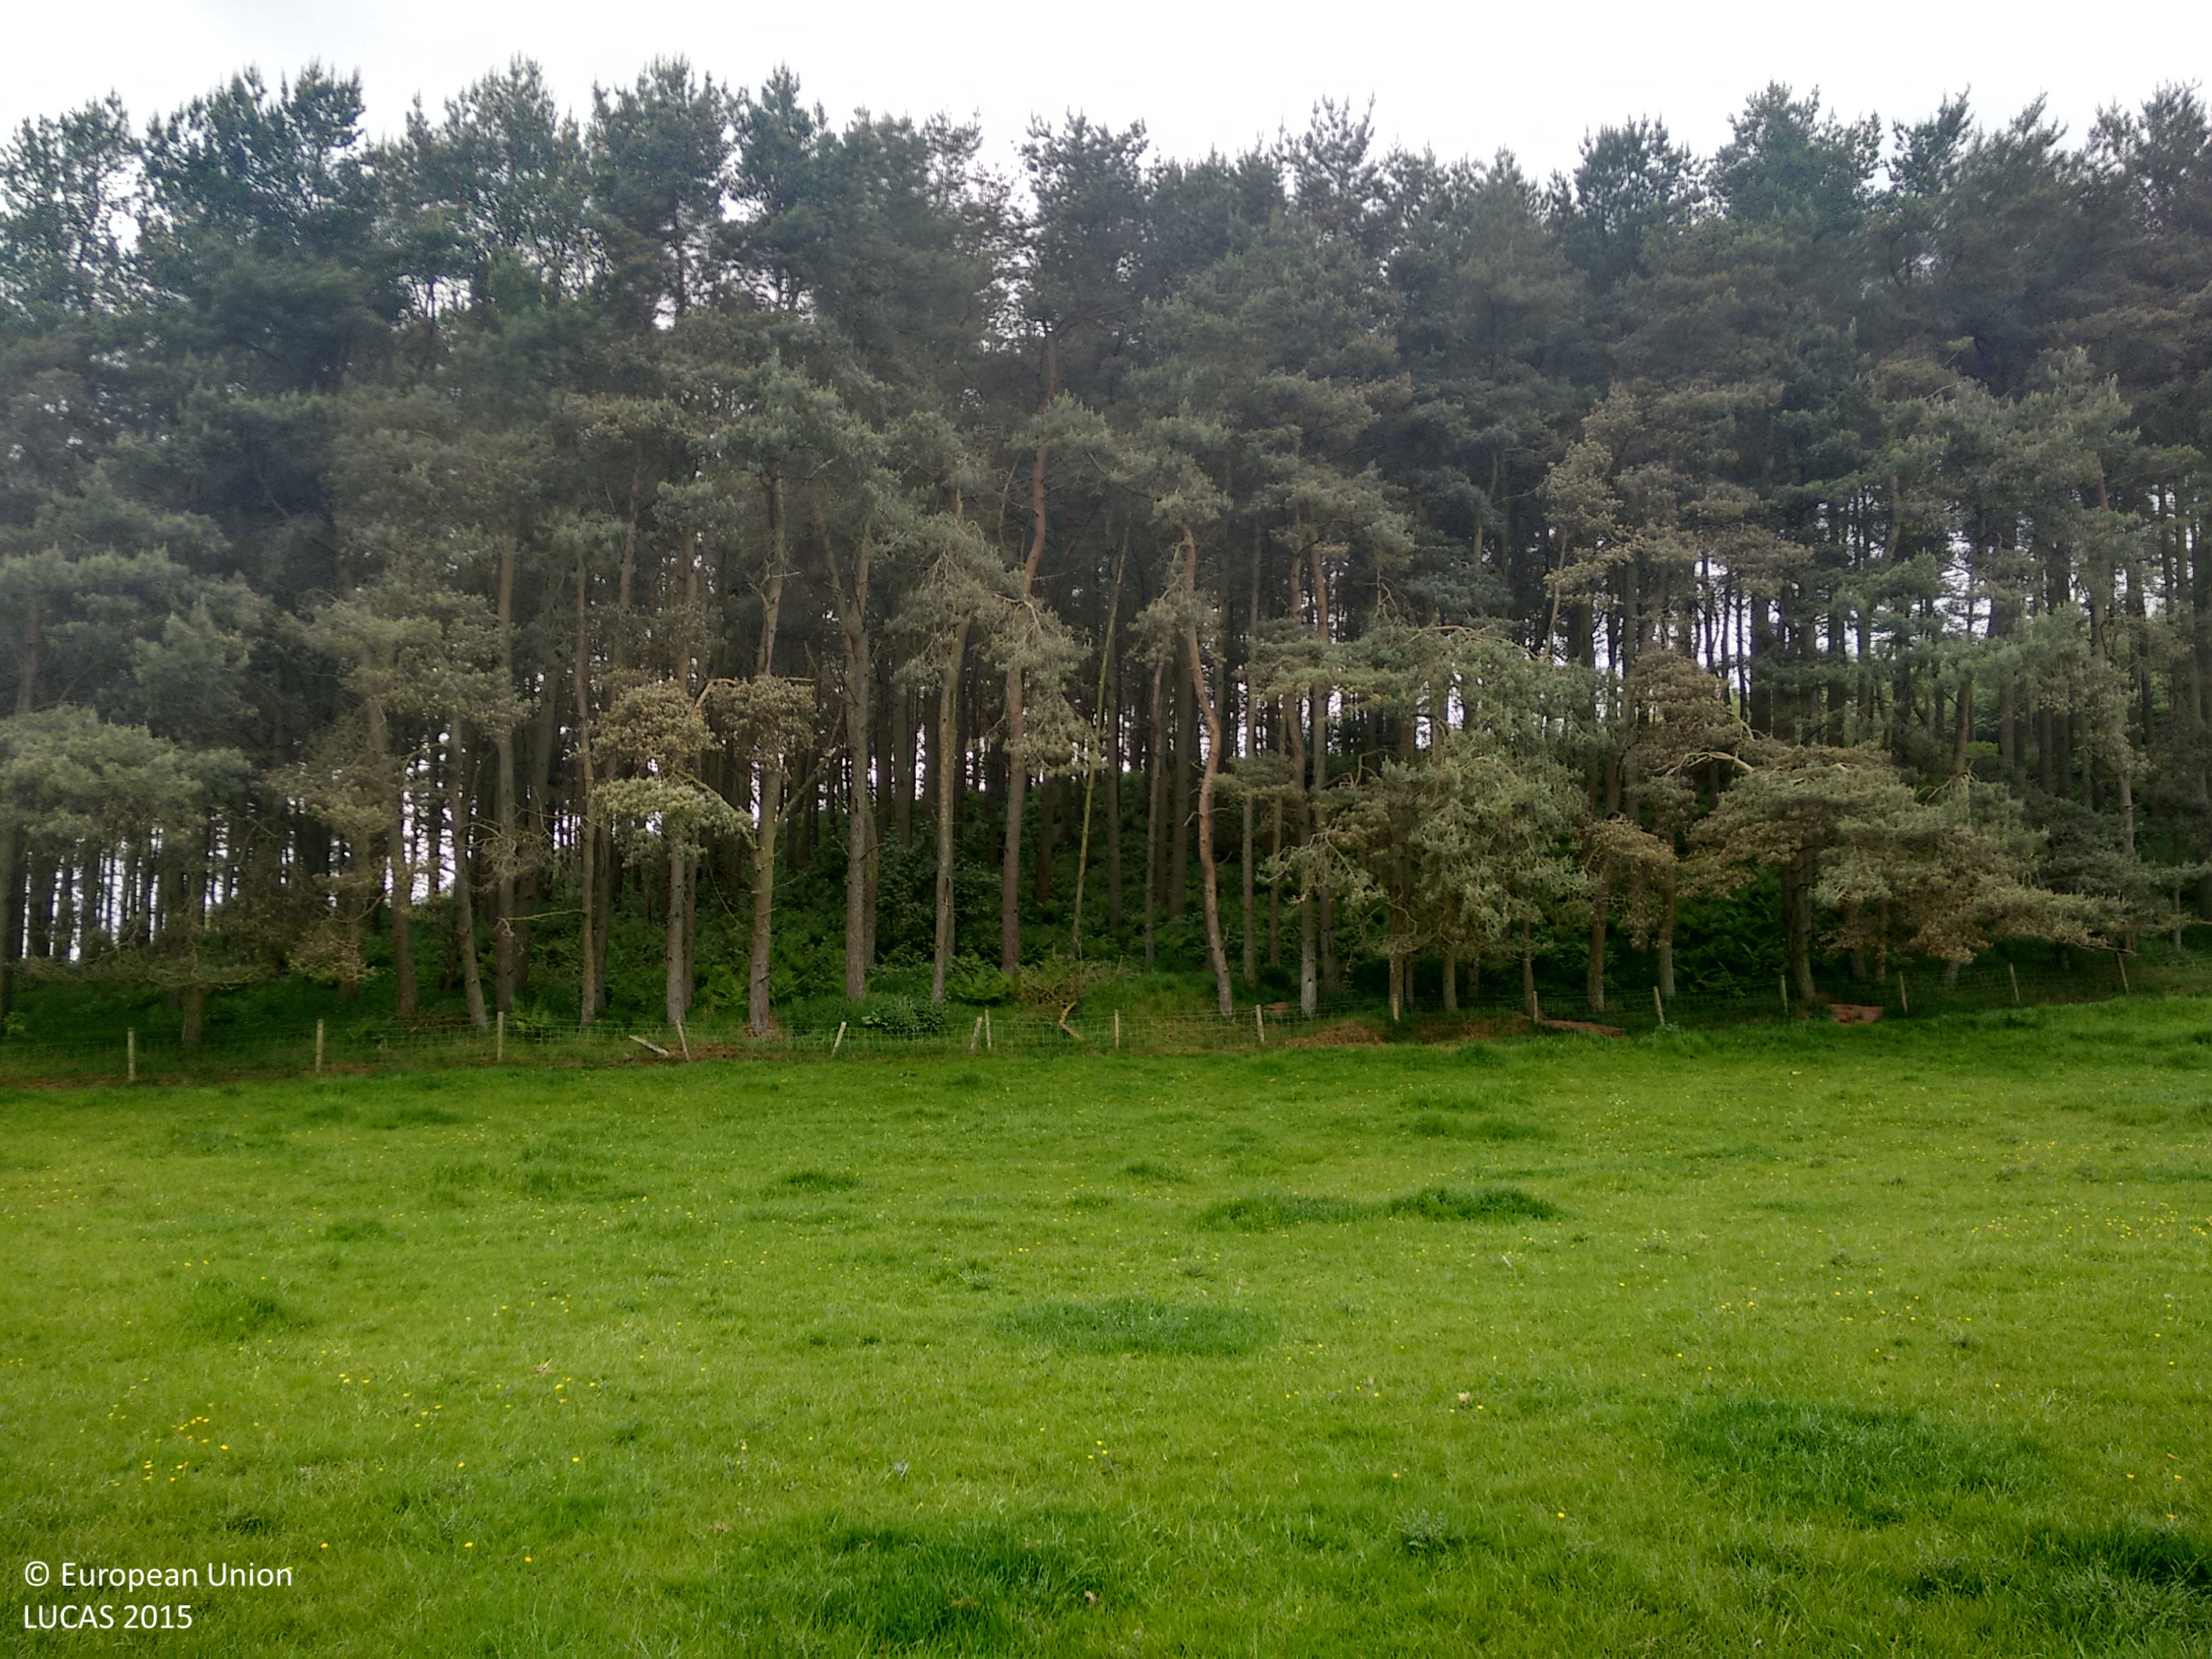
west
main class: Grassland
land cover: Grassland without tree/shrub cover
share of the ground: > 75 %
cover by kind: herbaceous plants 100 %
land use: Agriculture (excluding fallow land and kitchen gardens)
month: June
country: GB
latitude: 55.6978
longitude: -3.5882
